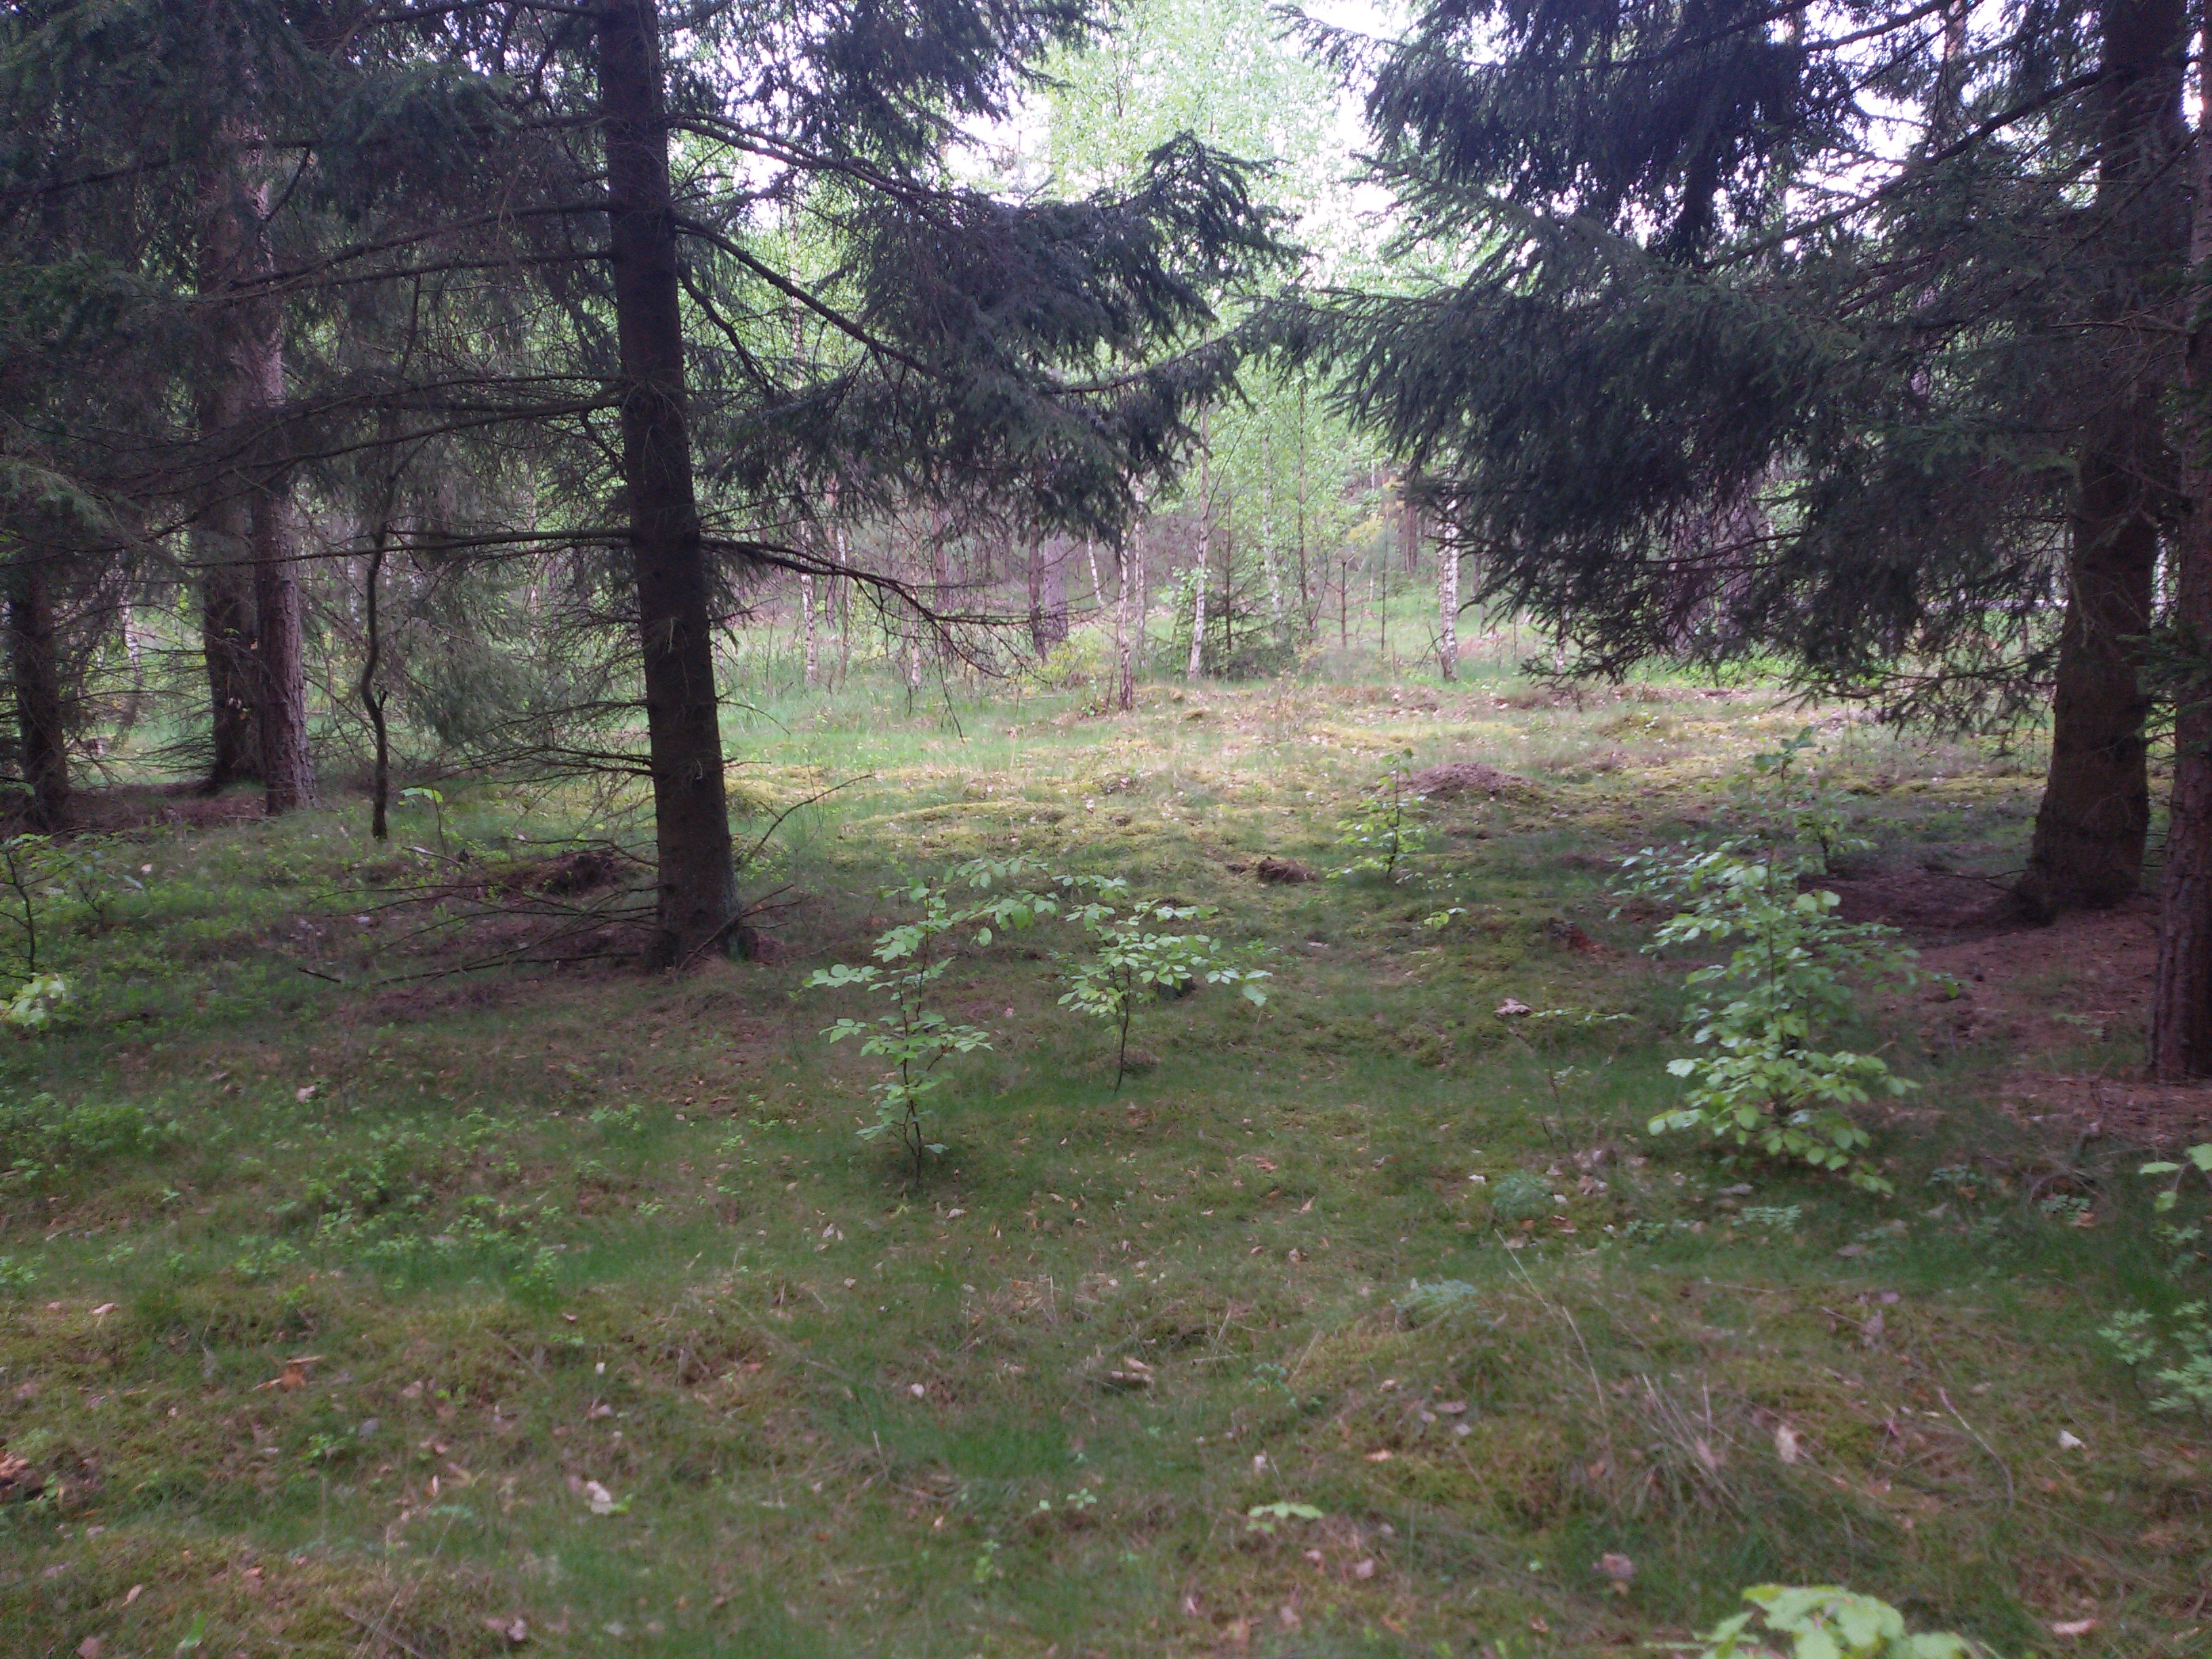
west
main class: Woodland
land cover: Pine dominated coniferous woodland
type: hemiboreal forest and nemoral coniferous forest and mixed broadleaved-coniferous forest
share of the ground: > 75 %
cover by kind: coniferous forest trees 80 %, shrubs 10 %, herbaceous plants 10 %
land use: Forestry
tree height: > 5 m
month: May
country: PL
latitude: 53.5661
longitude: 21.0511
